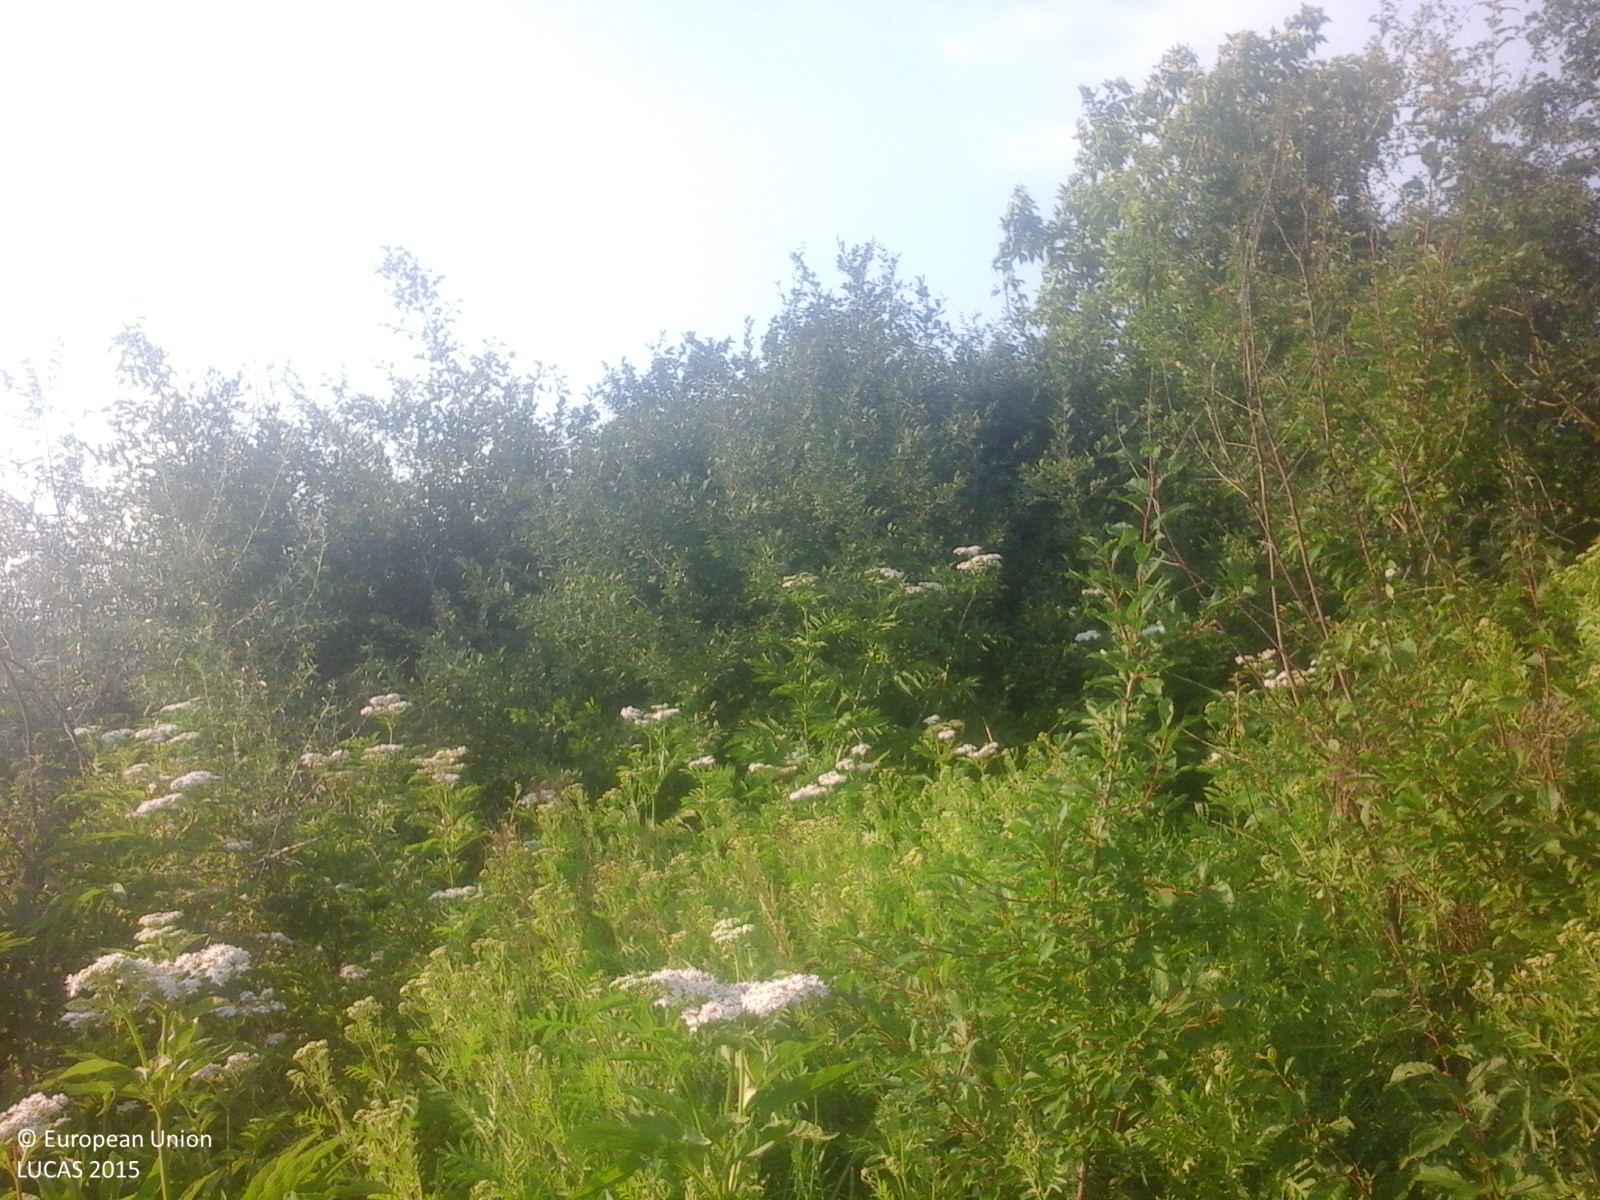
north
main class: Shrubland
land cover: Shrubland with sparse tree cover
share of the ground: > 75 %
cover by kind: shrubs 95 %, broadleaved forest trees 5 %
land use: Semi-natural and natural areas not in use
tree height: < 5 m
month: June
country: RO
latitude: 46.7442
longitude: 27.7782
